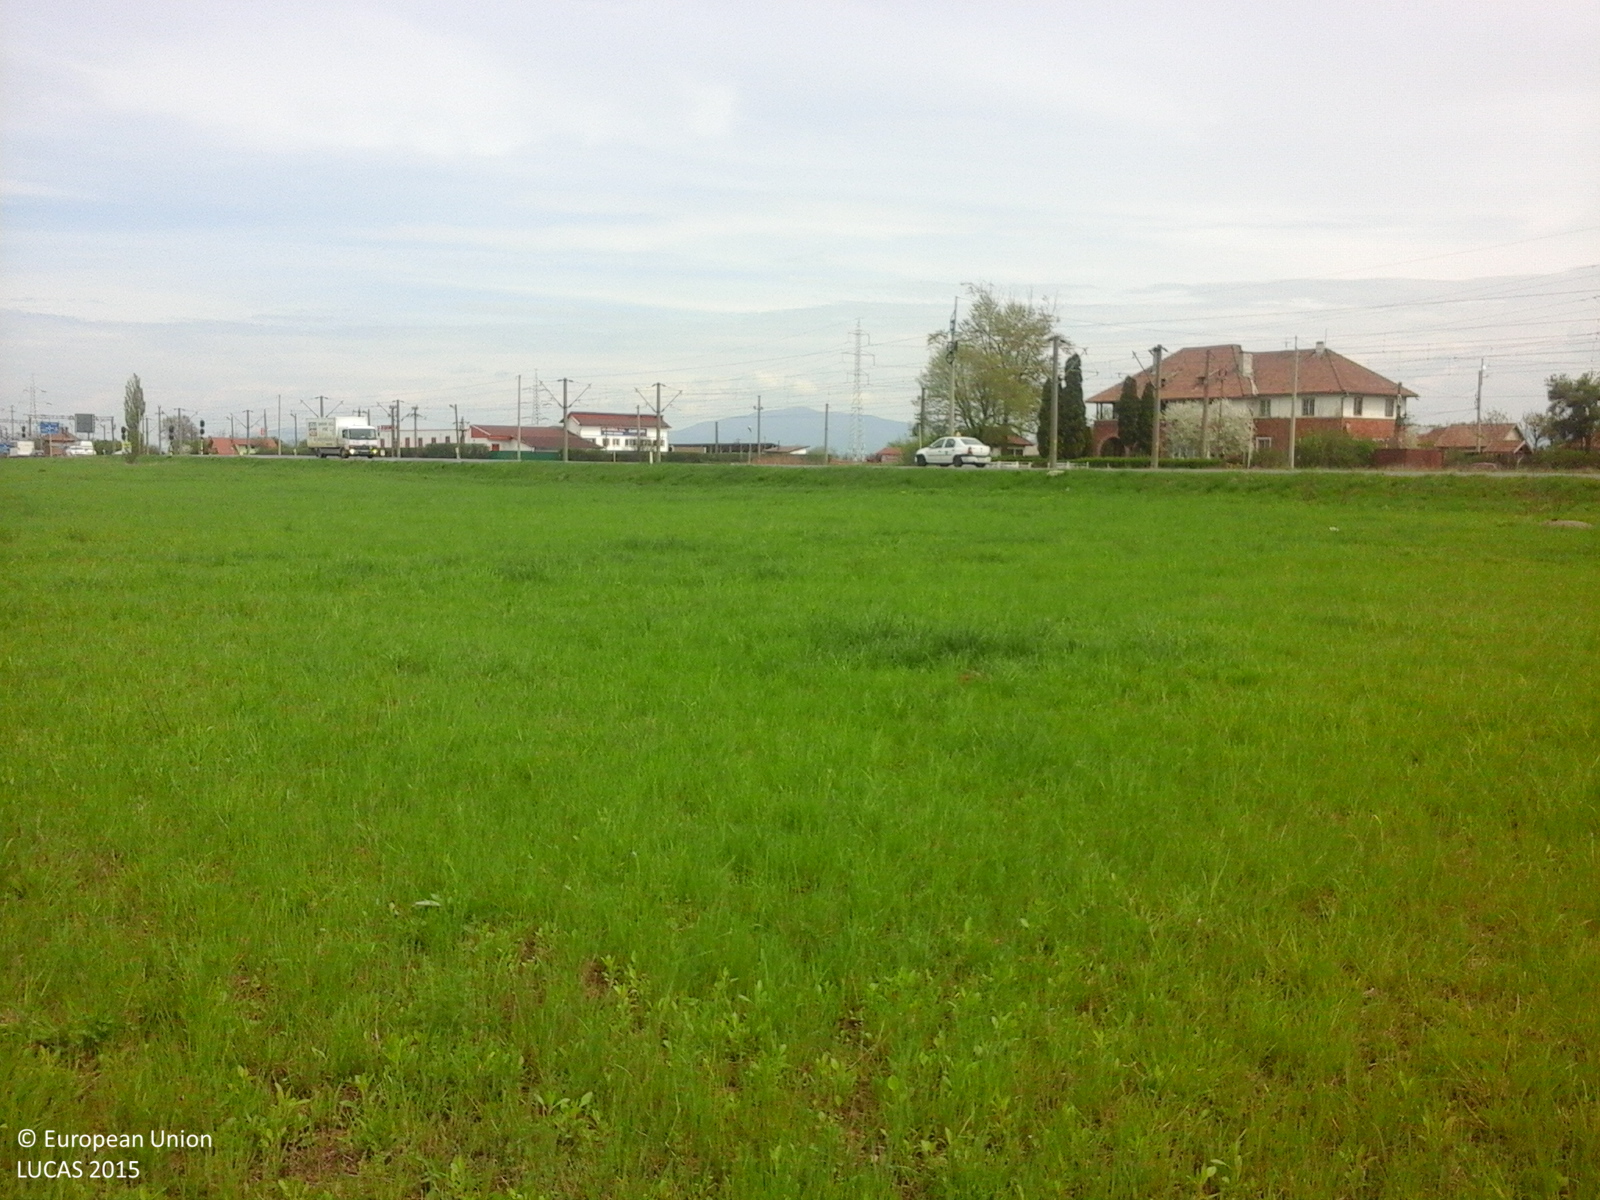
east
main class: Grassland
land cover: Grassland without tree/shrub cover
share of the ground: > 75 %
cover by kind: herbaceous plants 100 %
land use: Agriculture (excluding fallow land and kitchen gardens)
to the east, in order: Grassland without tree/shrub cover; Grass margins; Paved roads, cycling and walking lanes; Electric lines; Grassland without tree/shrub cover; Artificial constructions in urban areas; Grassland without tree/shrub cover; Paved roads, cycling and walking lanes
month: May
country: RO
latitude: 45.6983
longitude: 25.6852
